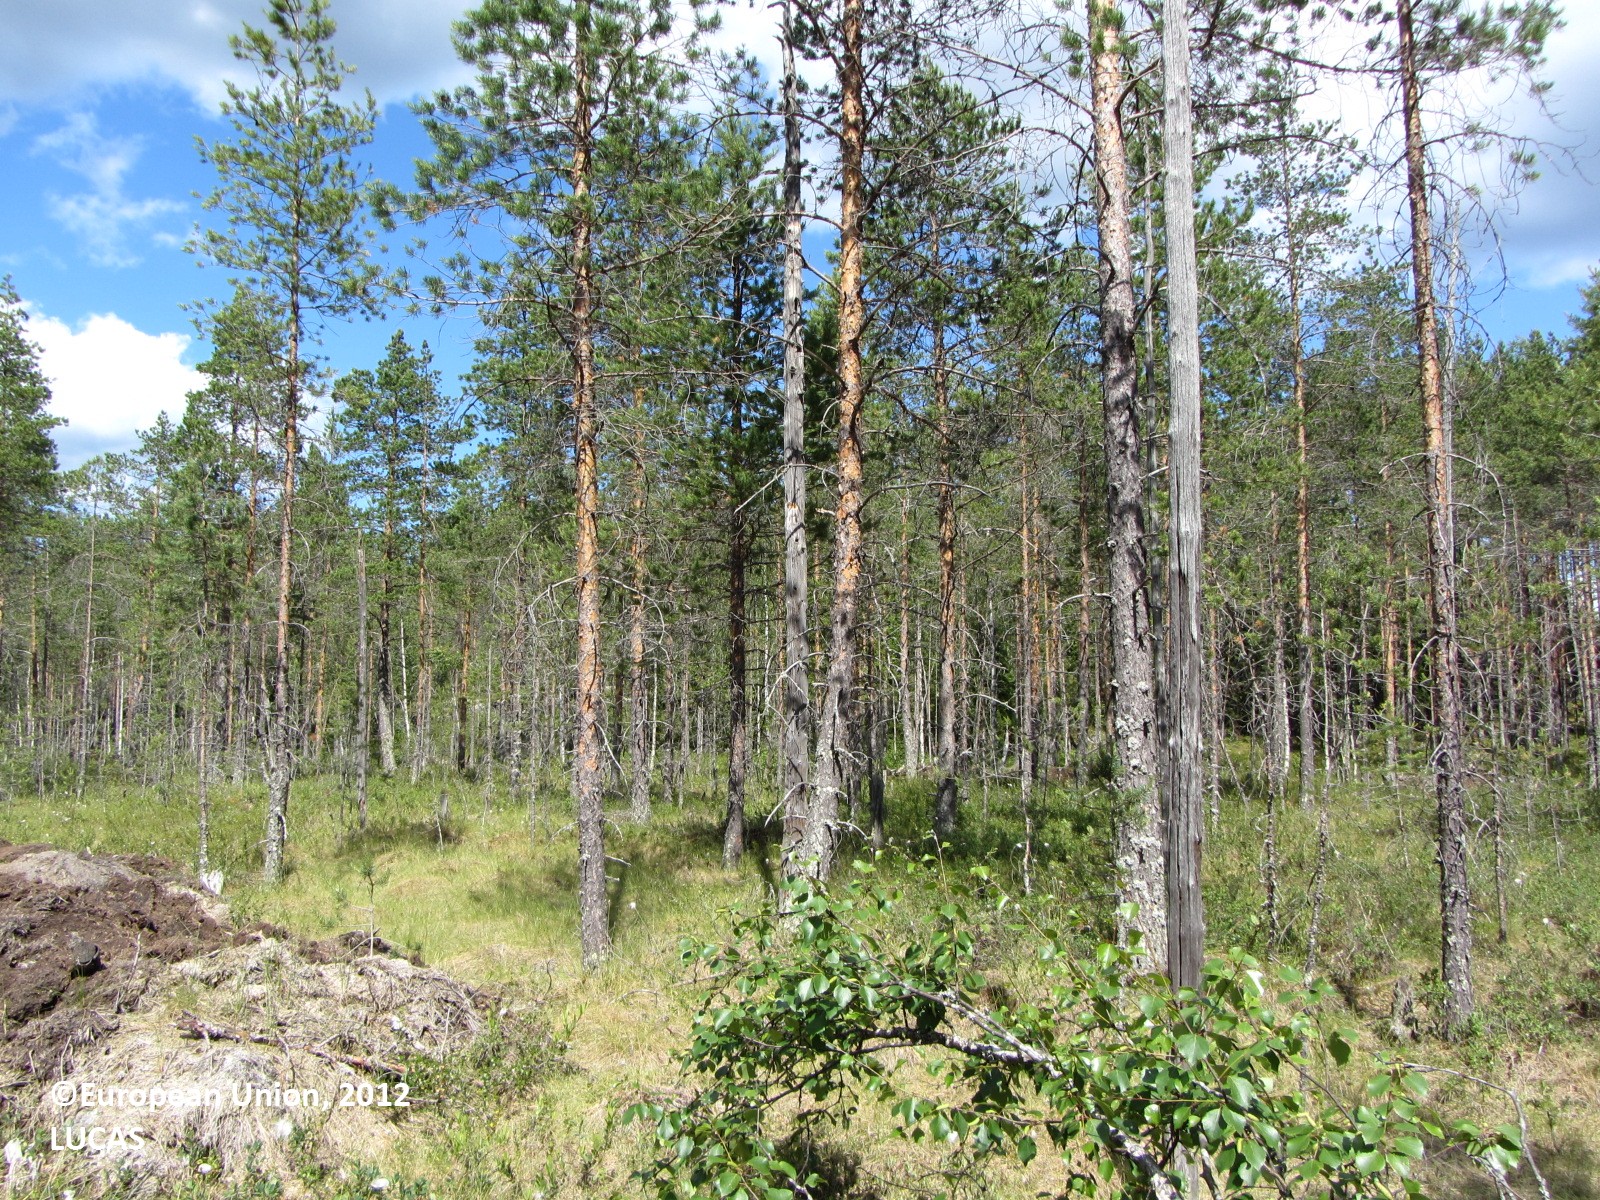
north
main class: Woodland
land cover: Pine dominated coniferous woodland
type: boreal forest
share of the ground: 50 - 75 %
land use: Forestry
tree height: > 5 m
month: July
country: FI
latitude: 63.2582
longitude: 25.3388
